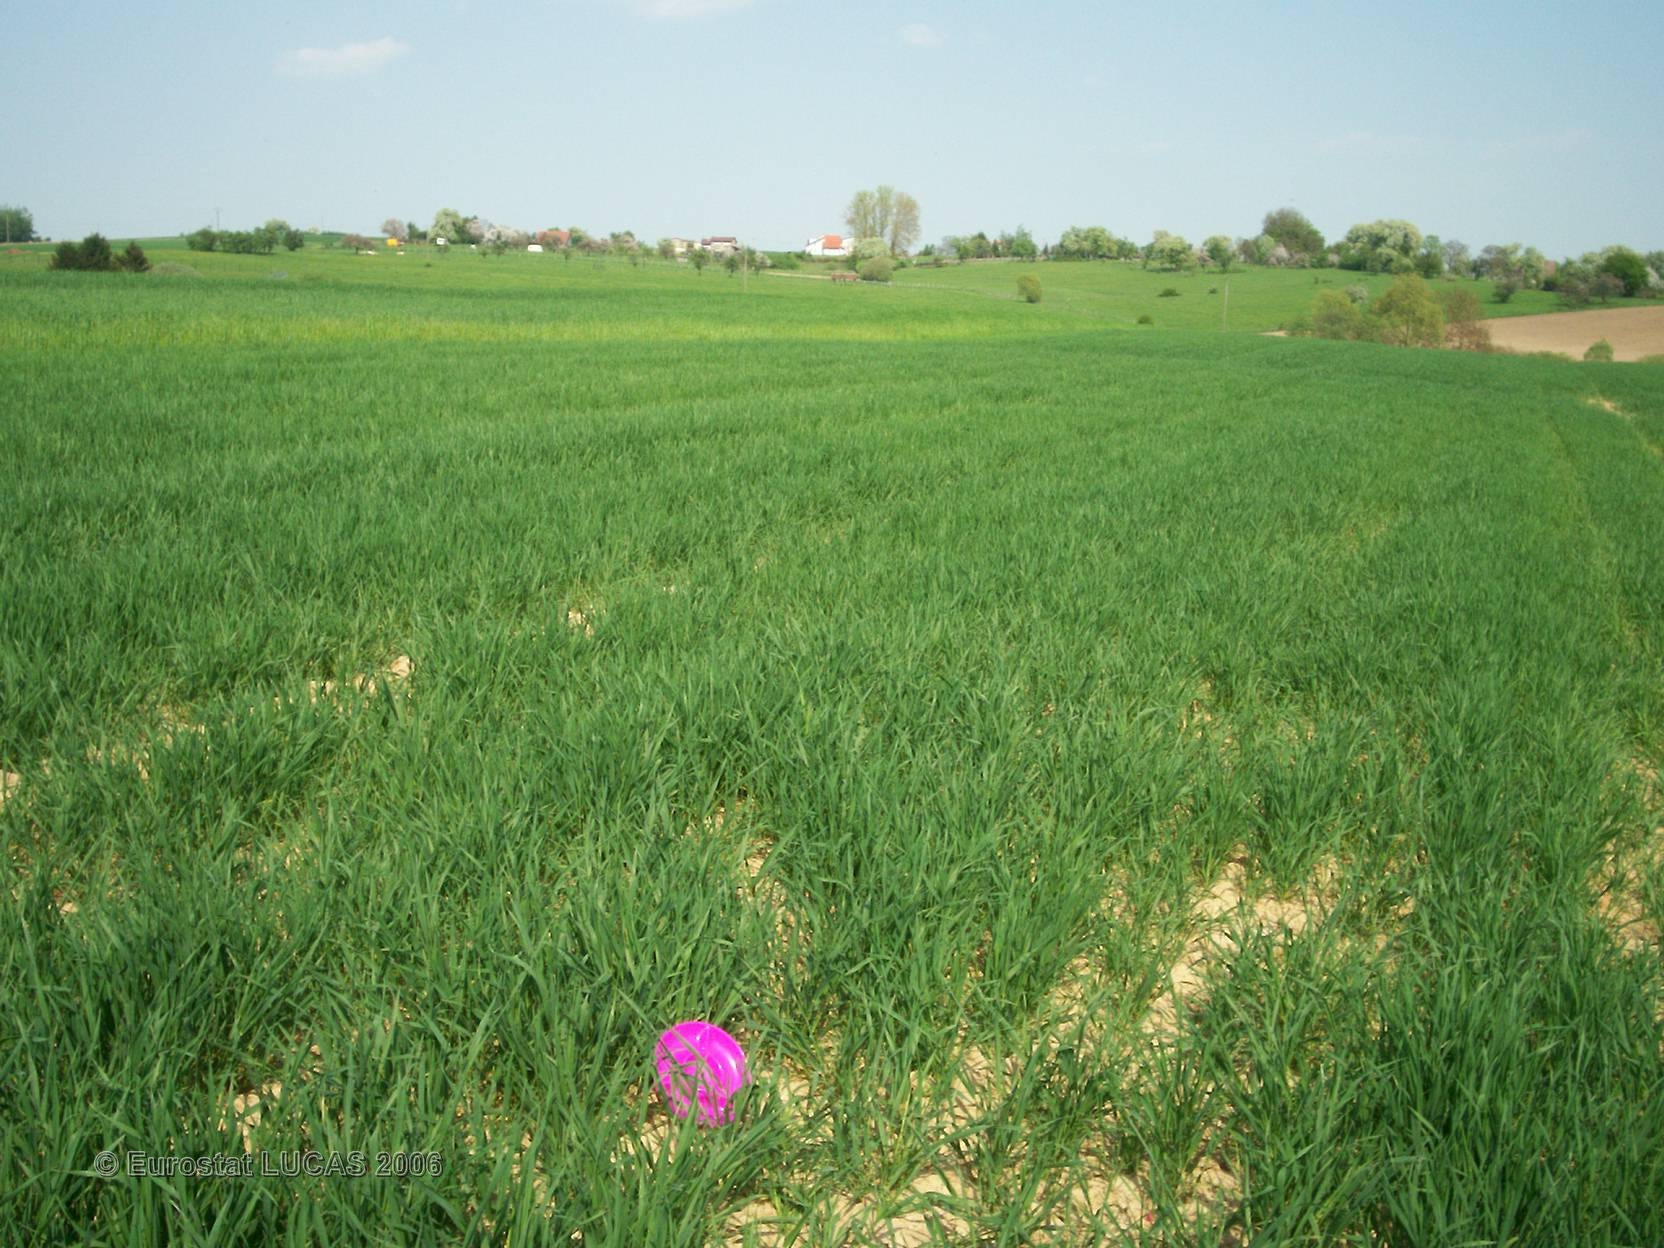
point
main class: Cropland
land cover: Common wheat
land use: Agriculture (excluding fallow land and kitchen gardens)
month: May
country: FR
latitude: 48.9190
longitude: 6.9299
